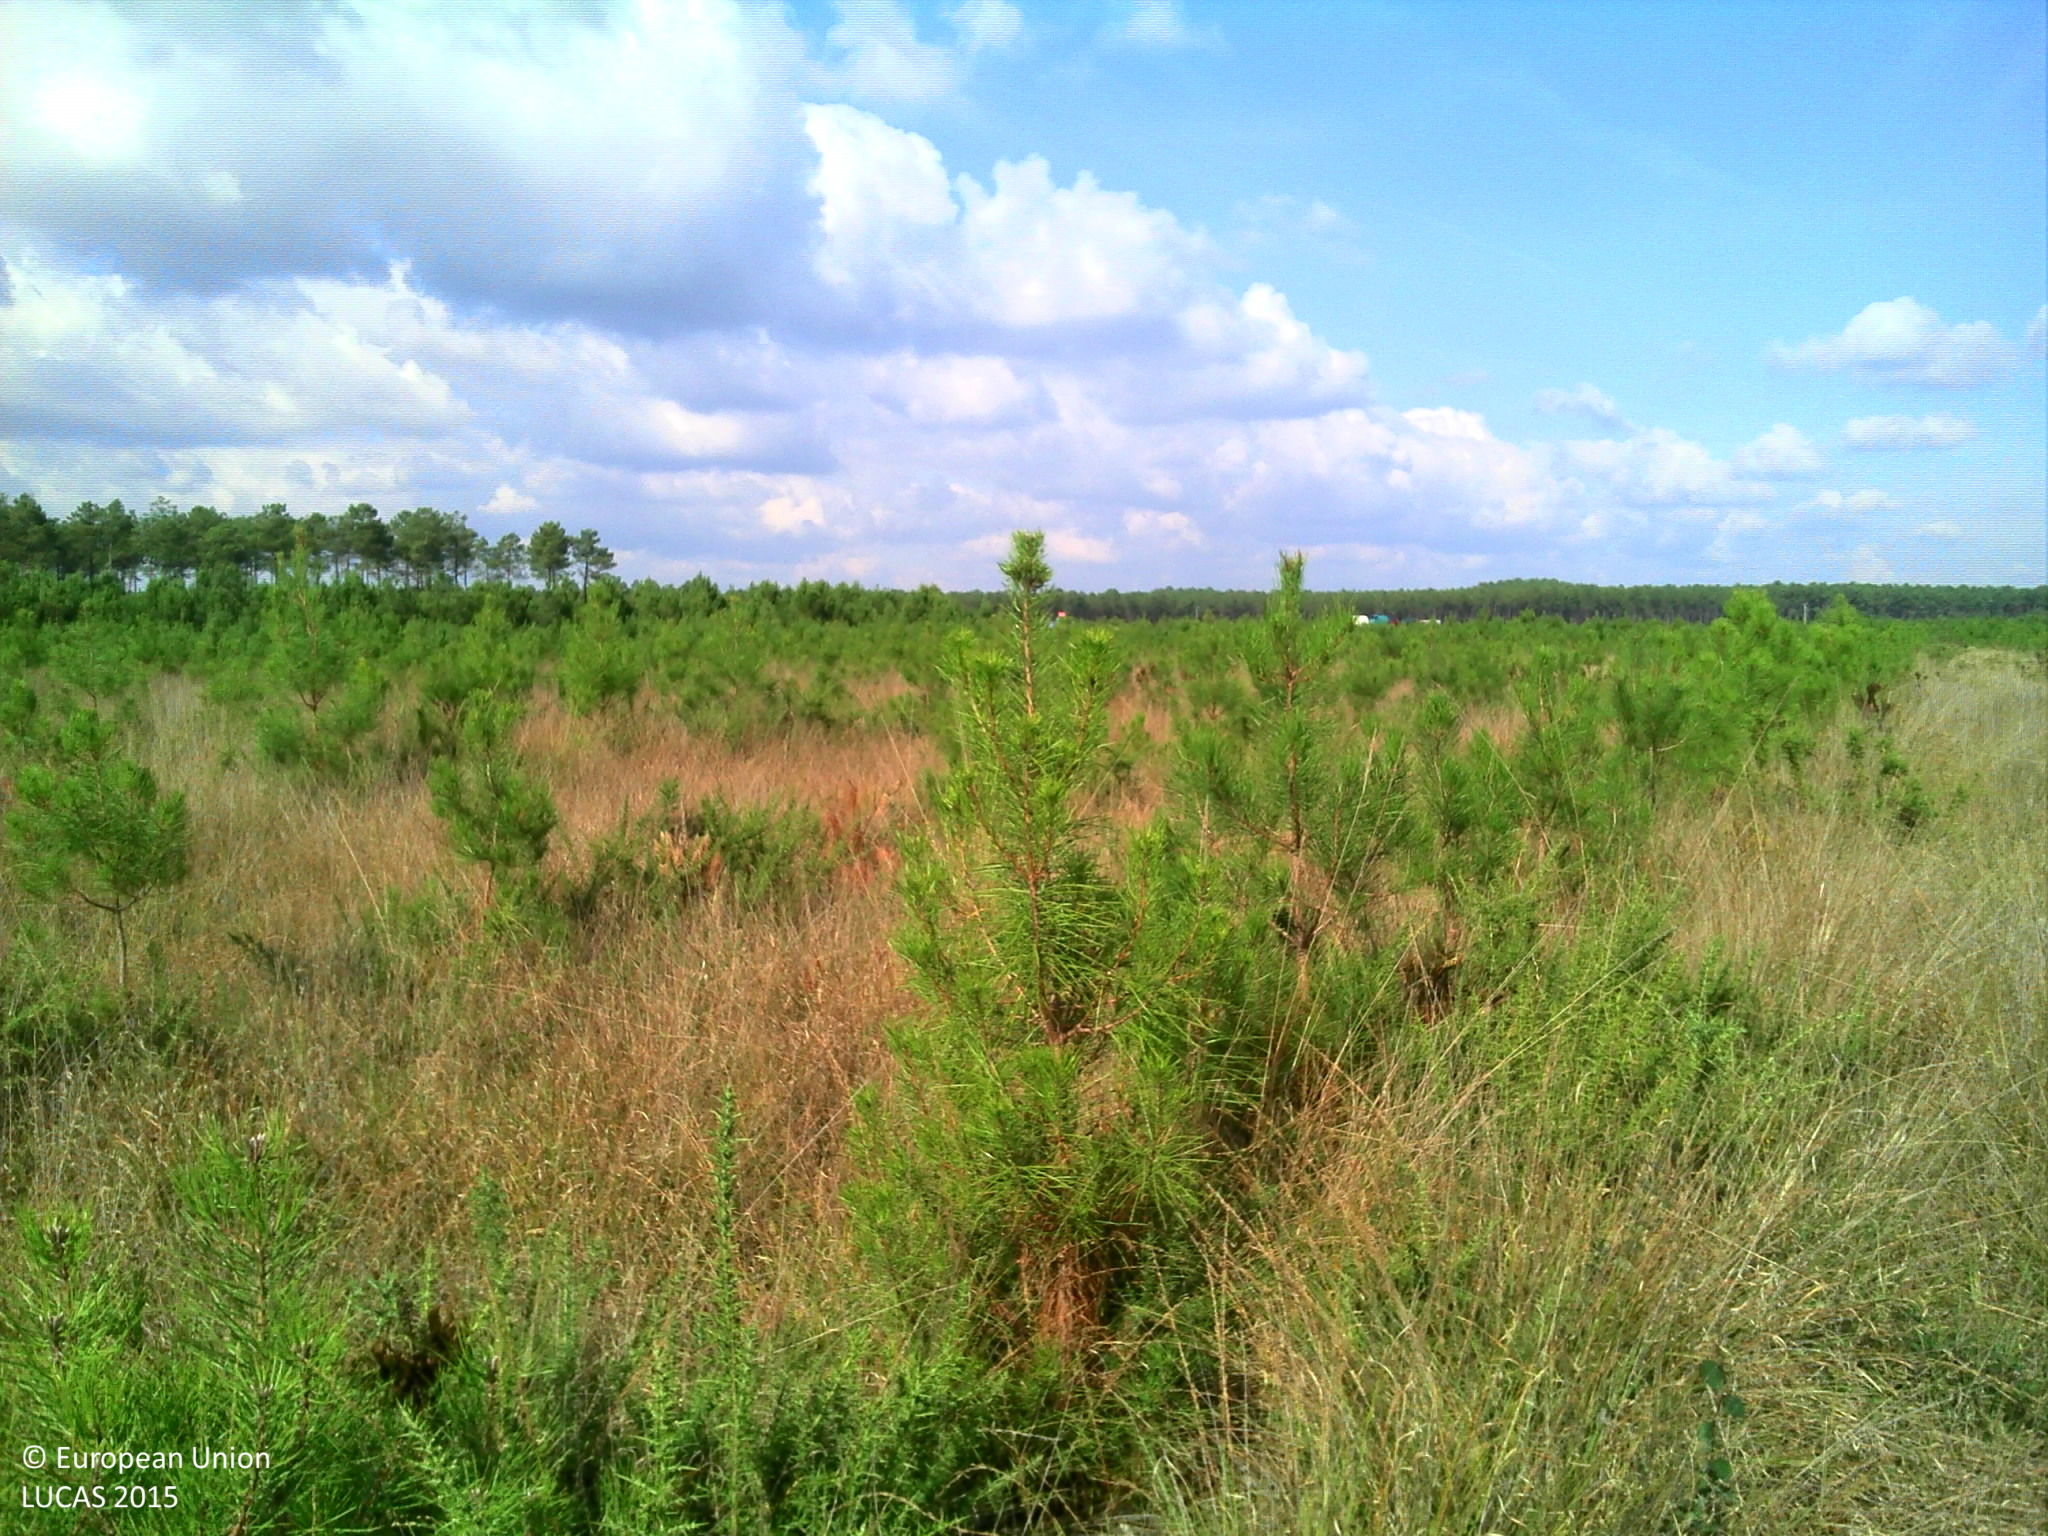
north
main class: Woodland
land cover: Pine dominated coniferous woodland
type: coniferous forest of the mediterranean region
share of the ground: 25 - 50 %
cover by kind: herbaceous plants 75 %, coniferous forest trees 25 %
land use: Forestry
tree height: > 5 m
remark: Nursery
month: October
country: FR
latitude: 43.9769
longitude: -1.0500
